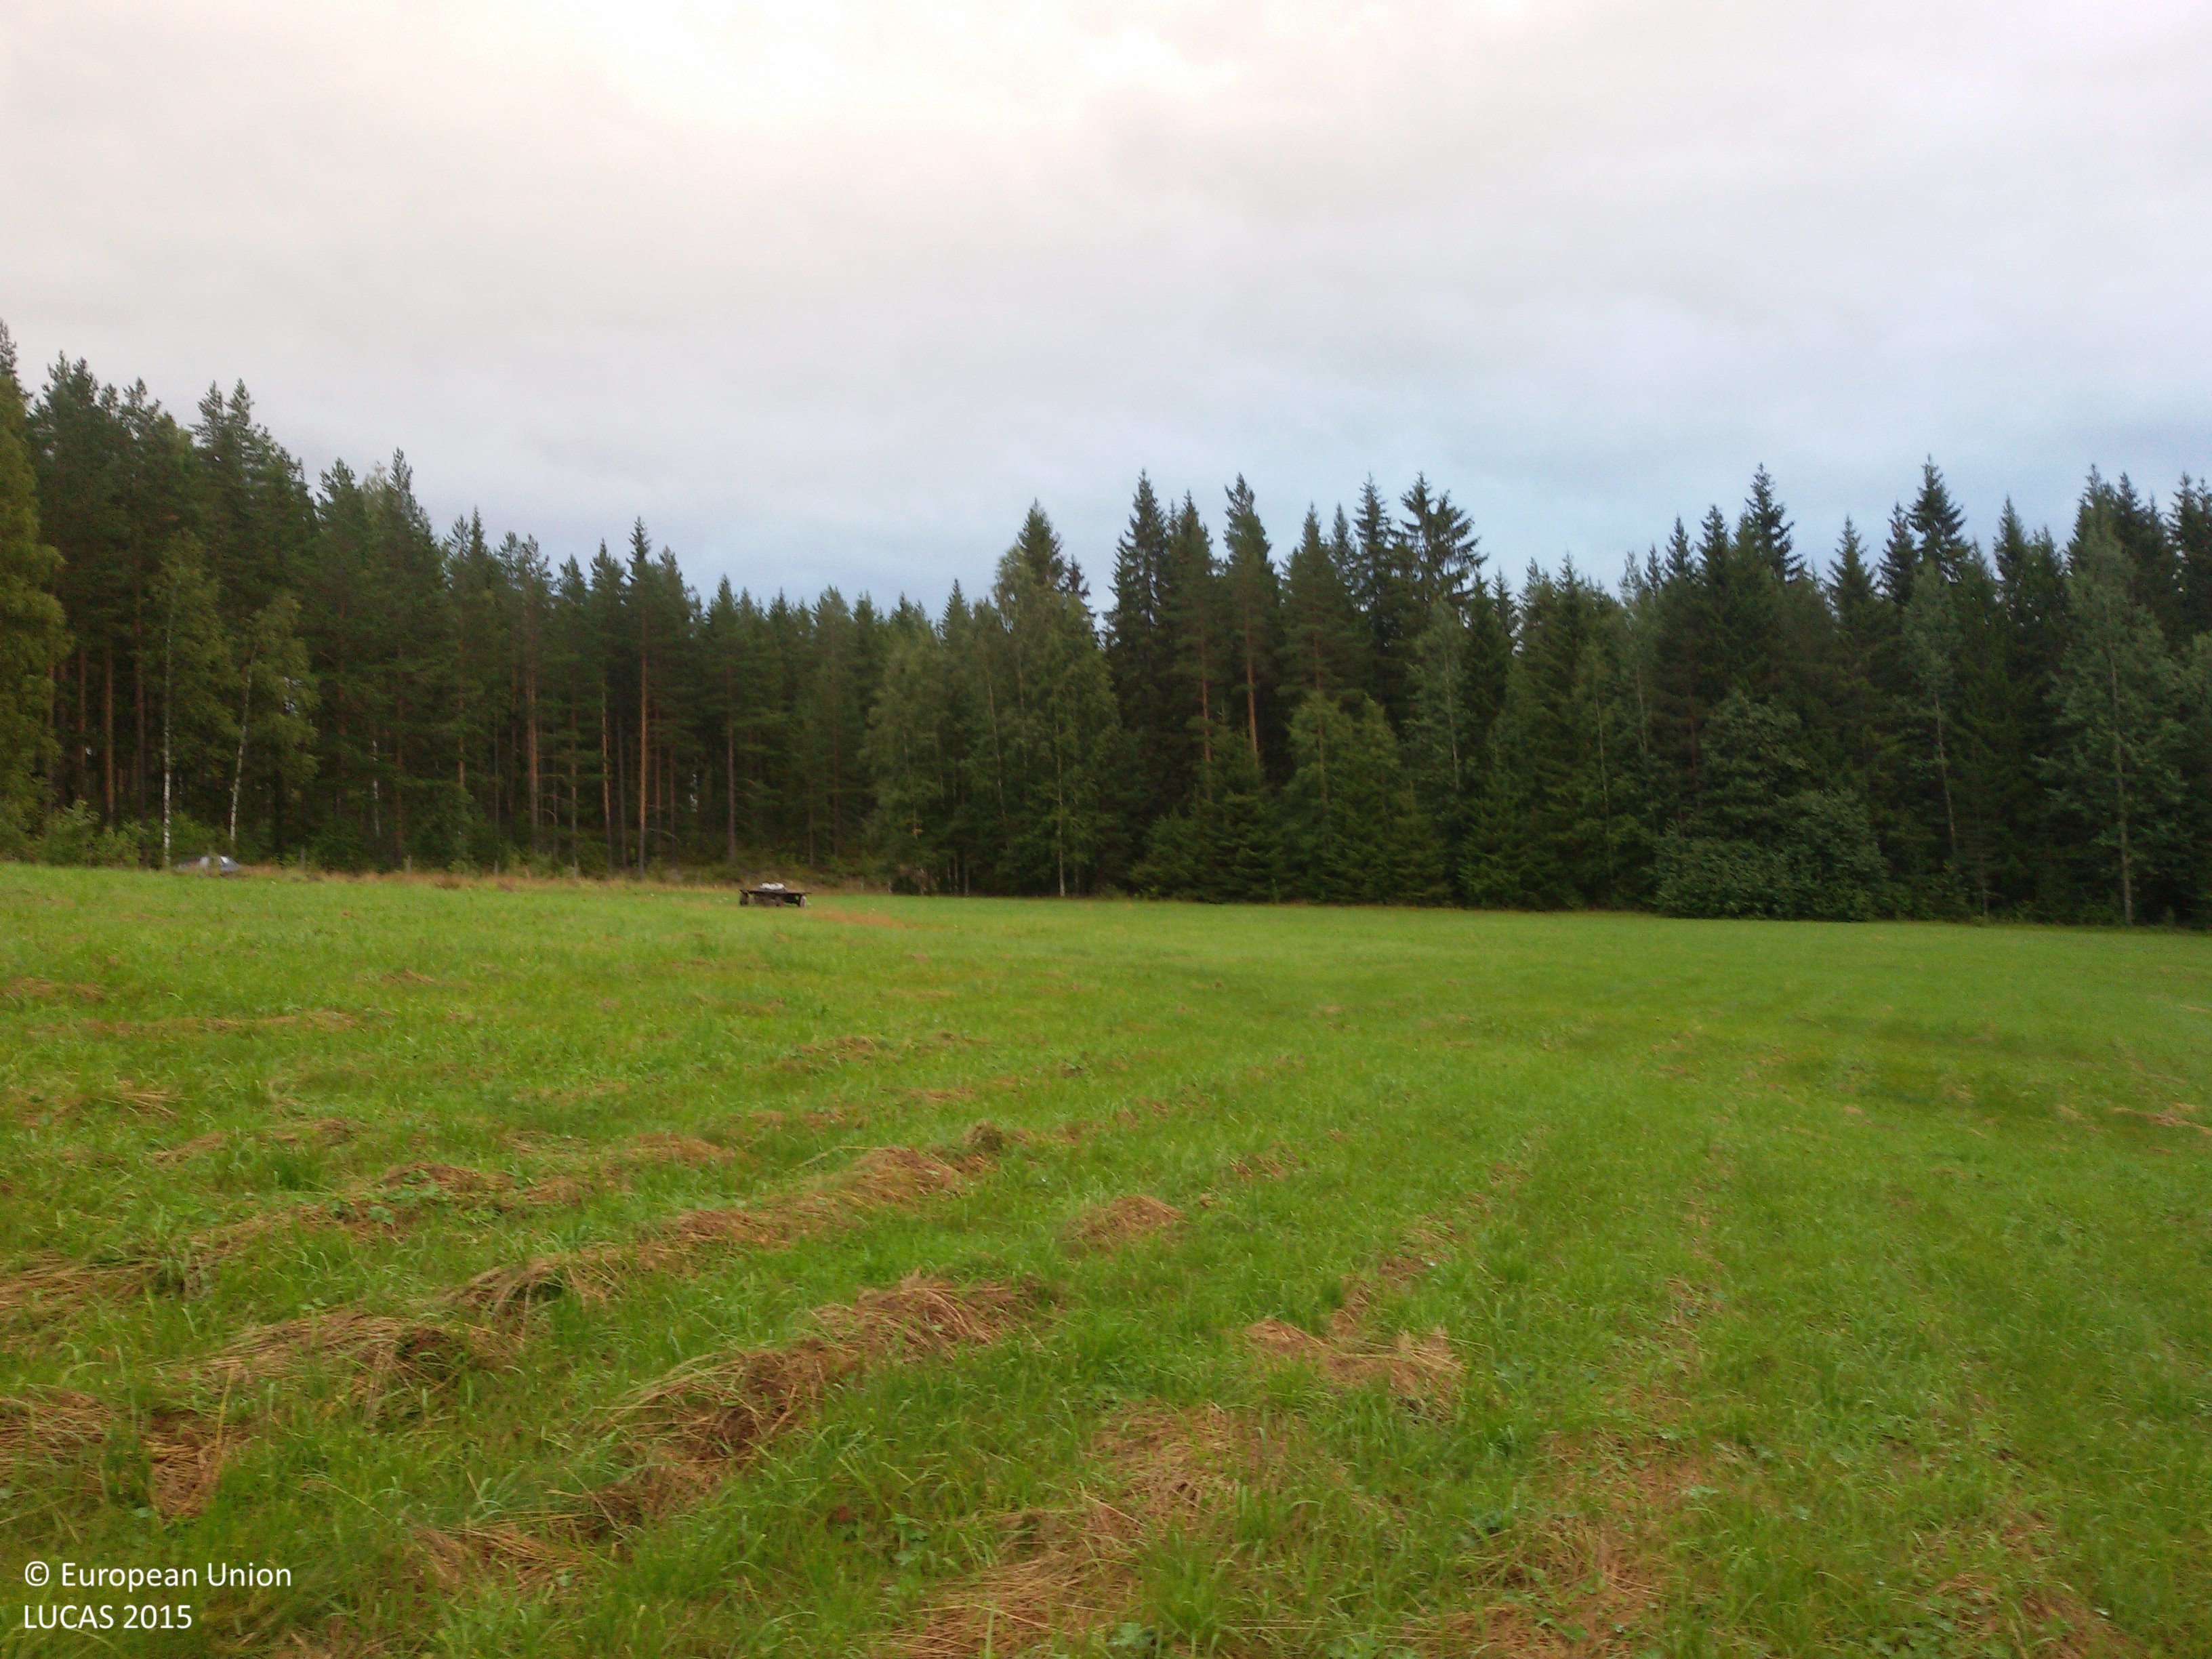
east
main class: Grassland
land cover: Grassland without tree/shrub cover
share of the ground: > 75 %
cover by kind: herbaceous plants 100 %
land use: Agriculture (excluding fallow land and kitchen gardens)
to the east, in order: Grassland without tree/shrub cover; Fences; Ditches and canals; Paved roads, cycling and walking lanes; Ditches and canals; Pine dominated coniferous woodland
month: August
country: SE
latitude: 60.9149
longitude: 16.5336
